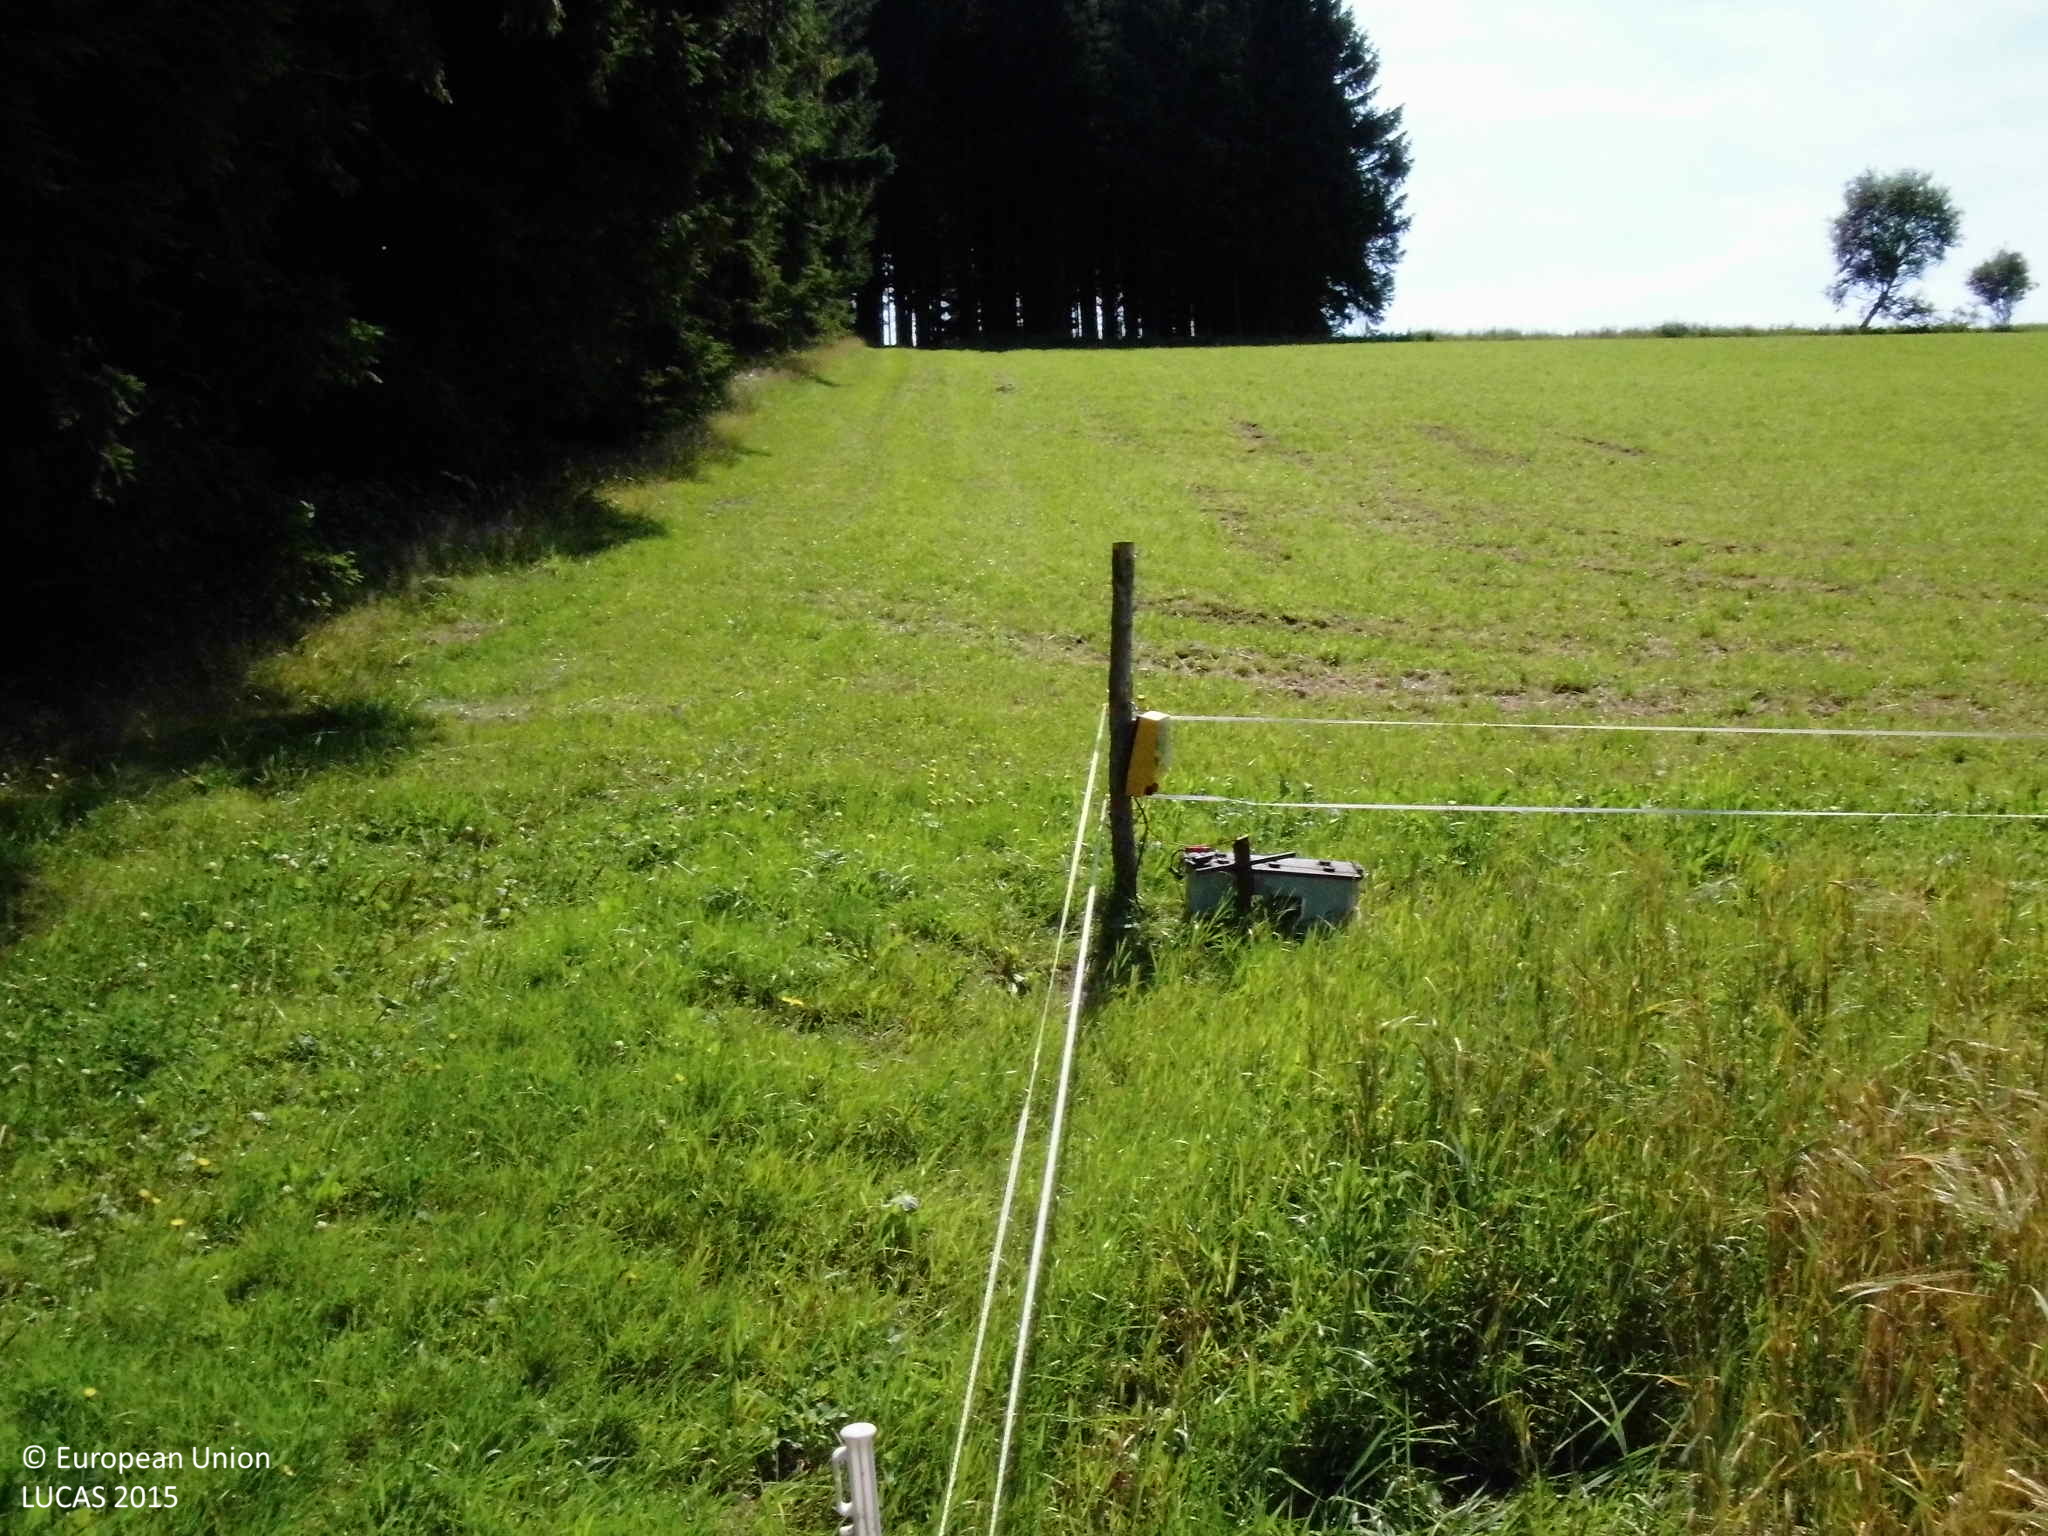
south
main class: Cropland
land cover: Barley
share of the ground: > 75 %
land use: Agriculture (excluding fallow land and kitchen gardens)
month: August
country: DE
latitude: 51.0732
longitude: 8.4732
